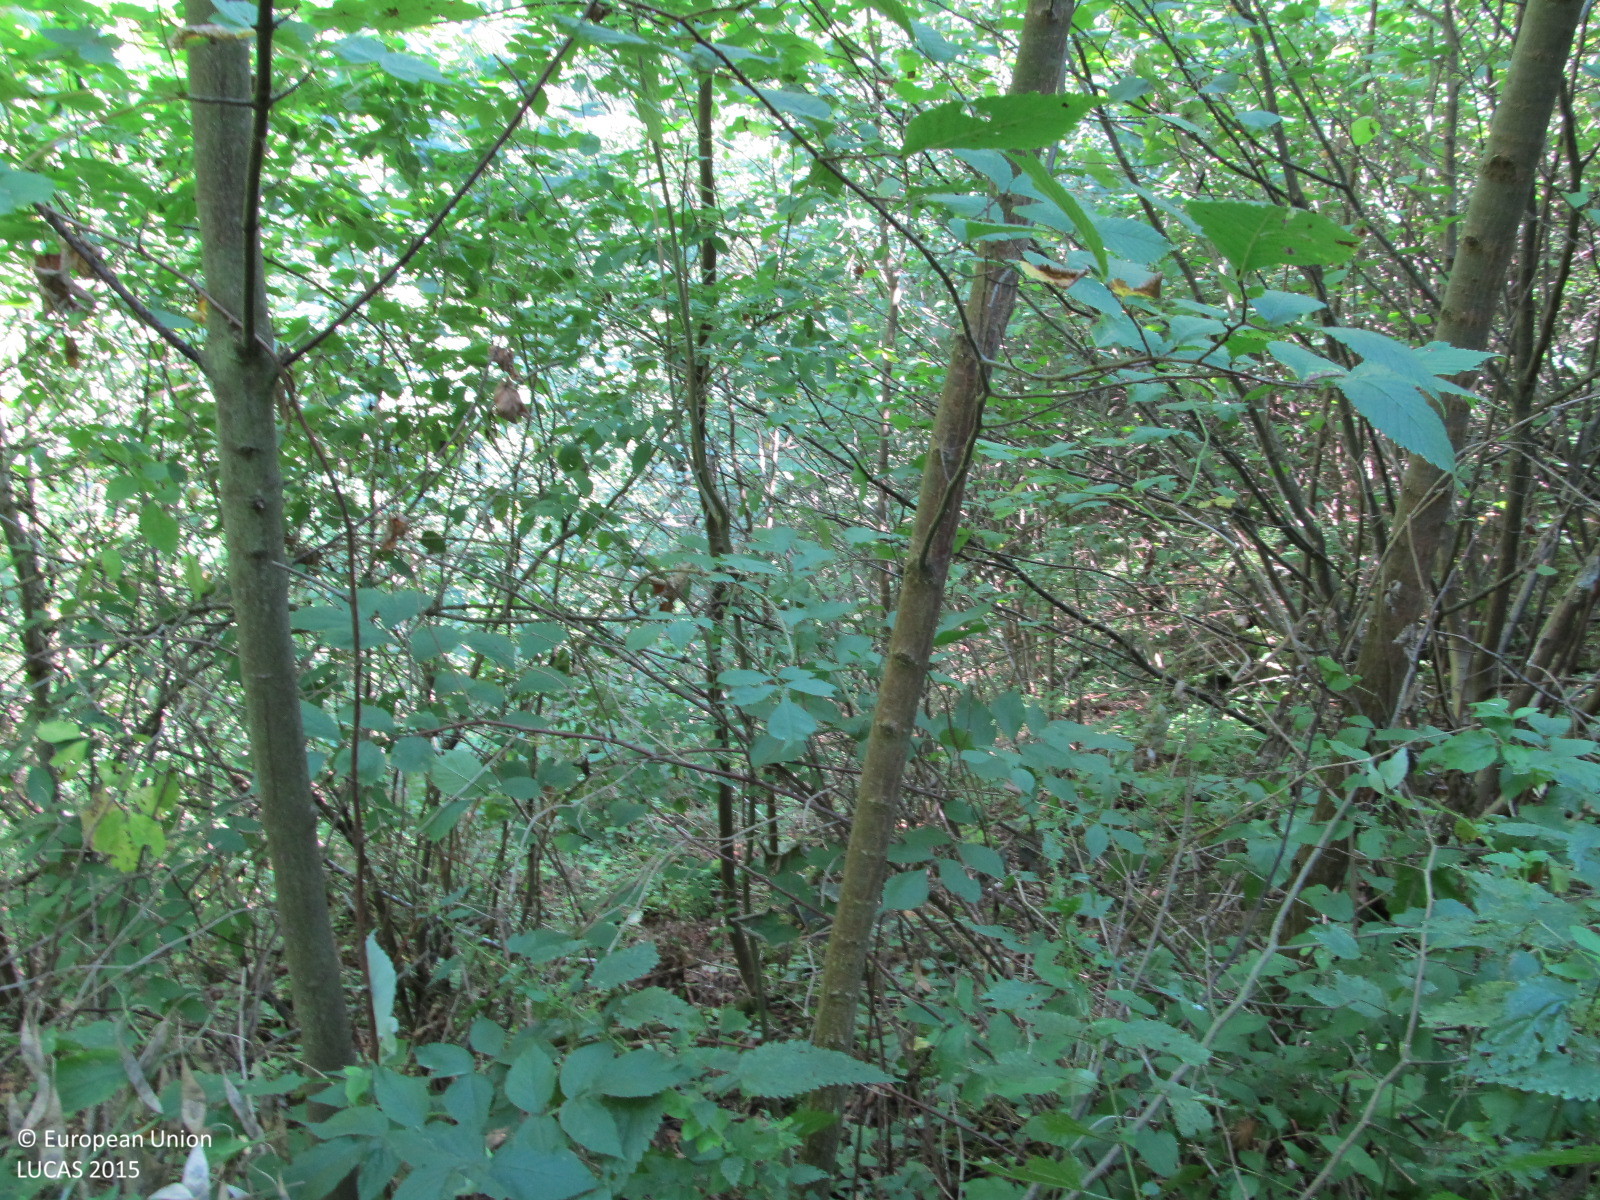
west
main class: Woodland
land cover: Broadleaved woodland
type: hemiboreal forest and nemoral coniferous forest and mixed broadleaved-coniferous forest
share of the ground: > 75 %
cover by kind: broadleaved forest trees 85 %, shrubs 5 %, herbaceous plants 5 %, unconsolidated bare surface 5 %
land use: Semi-natural and natural areas not in use
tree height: > 5 m
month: August
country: AT
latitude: 48.4520
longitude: 15.3973
